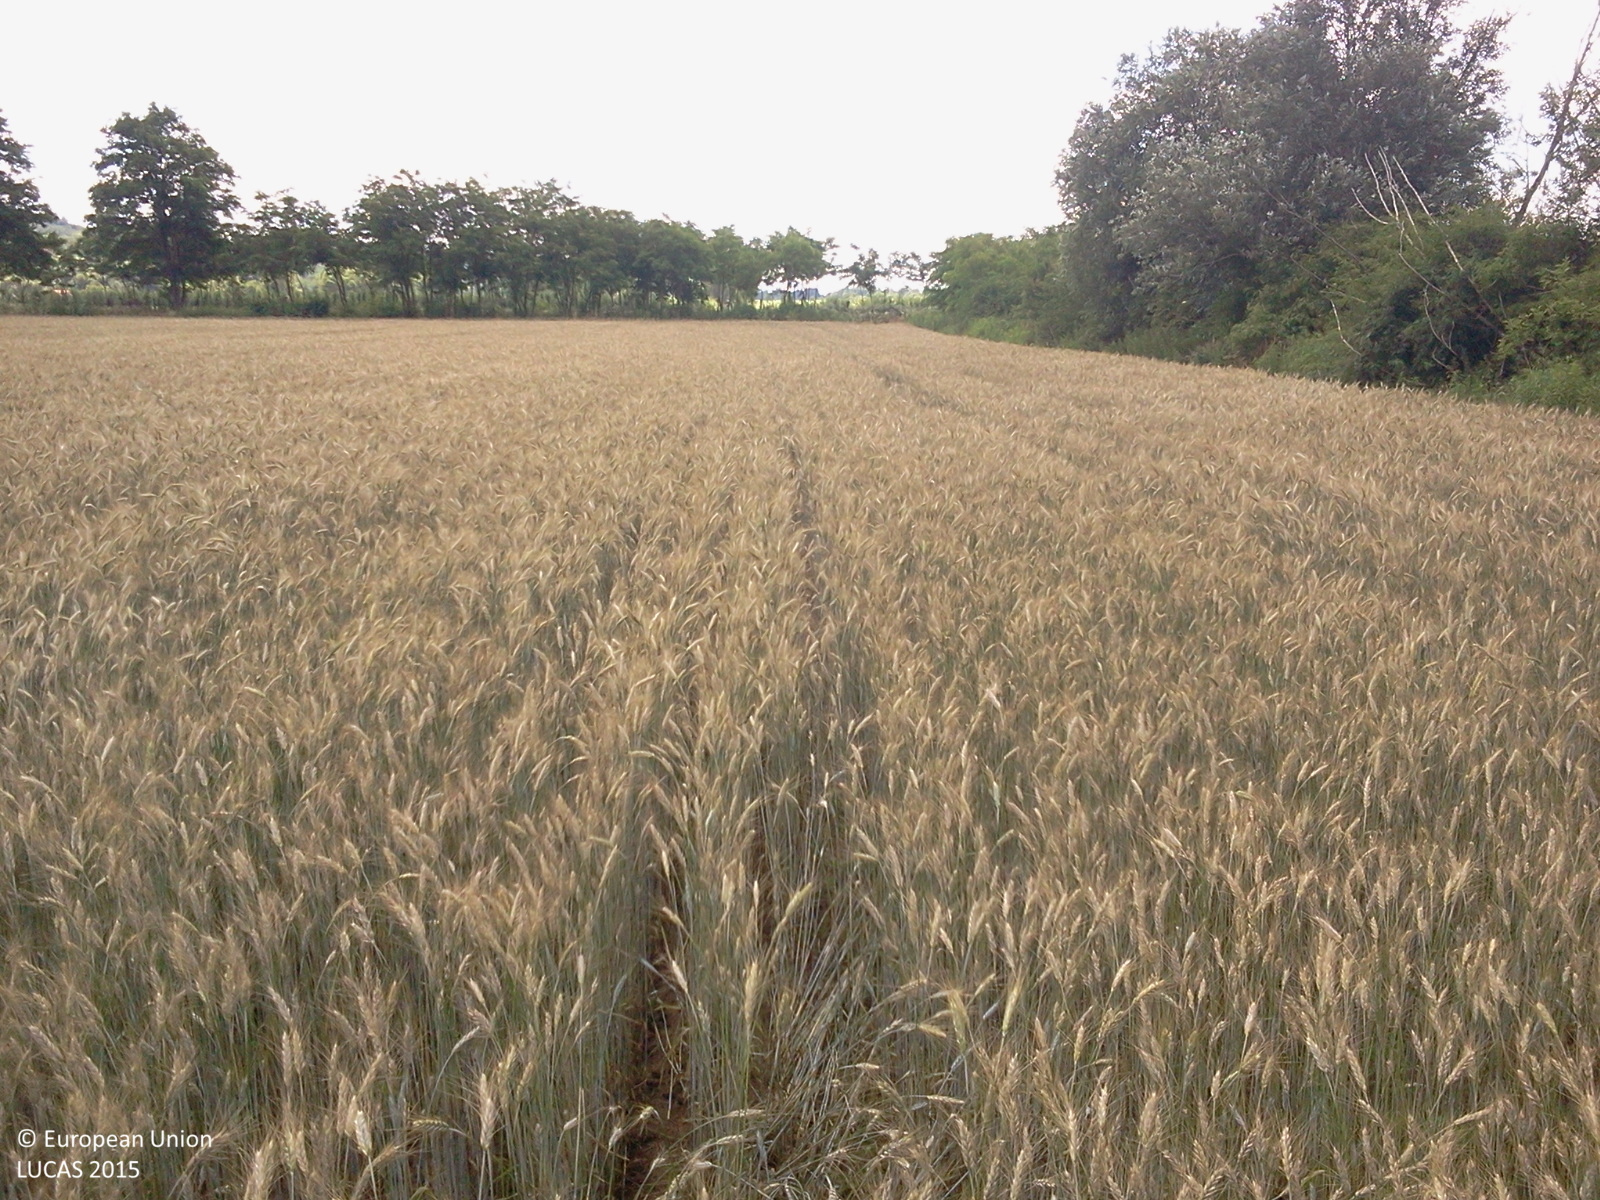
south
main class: Cropland
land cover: Durum wheat
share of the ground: > 75 %
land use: Agriculture (excluding fallow land and kitchen gardens)
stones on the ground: < 10 %
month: June
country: HU
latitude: 46.9637
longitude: 17.1147
